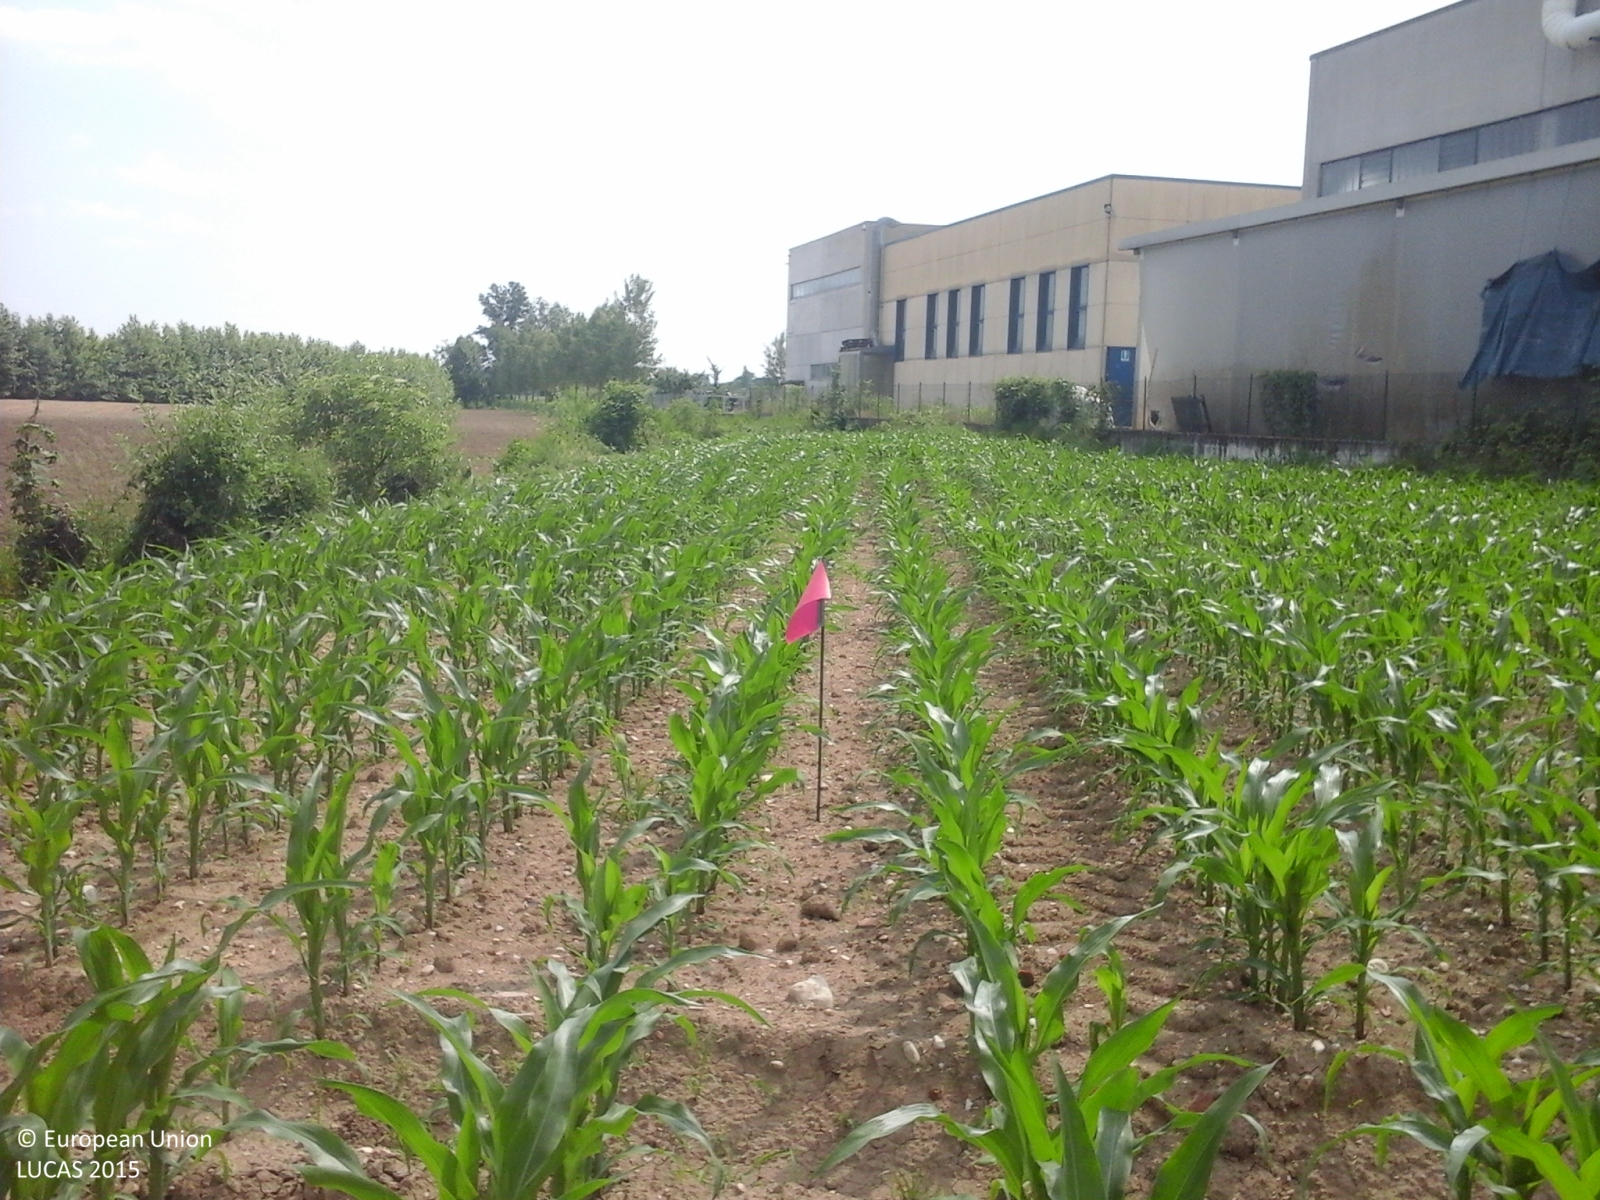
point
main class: Cropland
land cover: Maize
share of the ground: 25 - 50 %
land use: Agriculture (excluding fallow land and kitchen gardens)
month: May
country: IT
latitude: 45.6188
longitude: 11.5749
